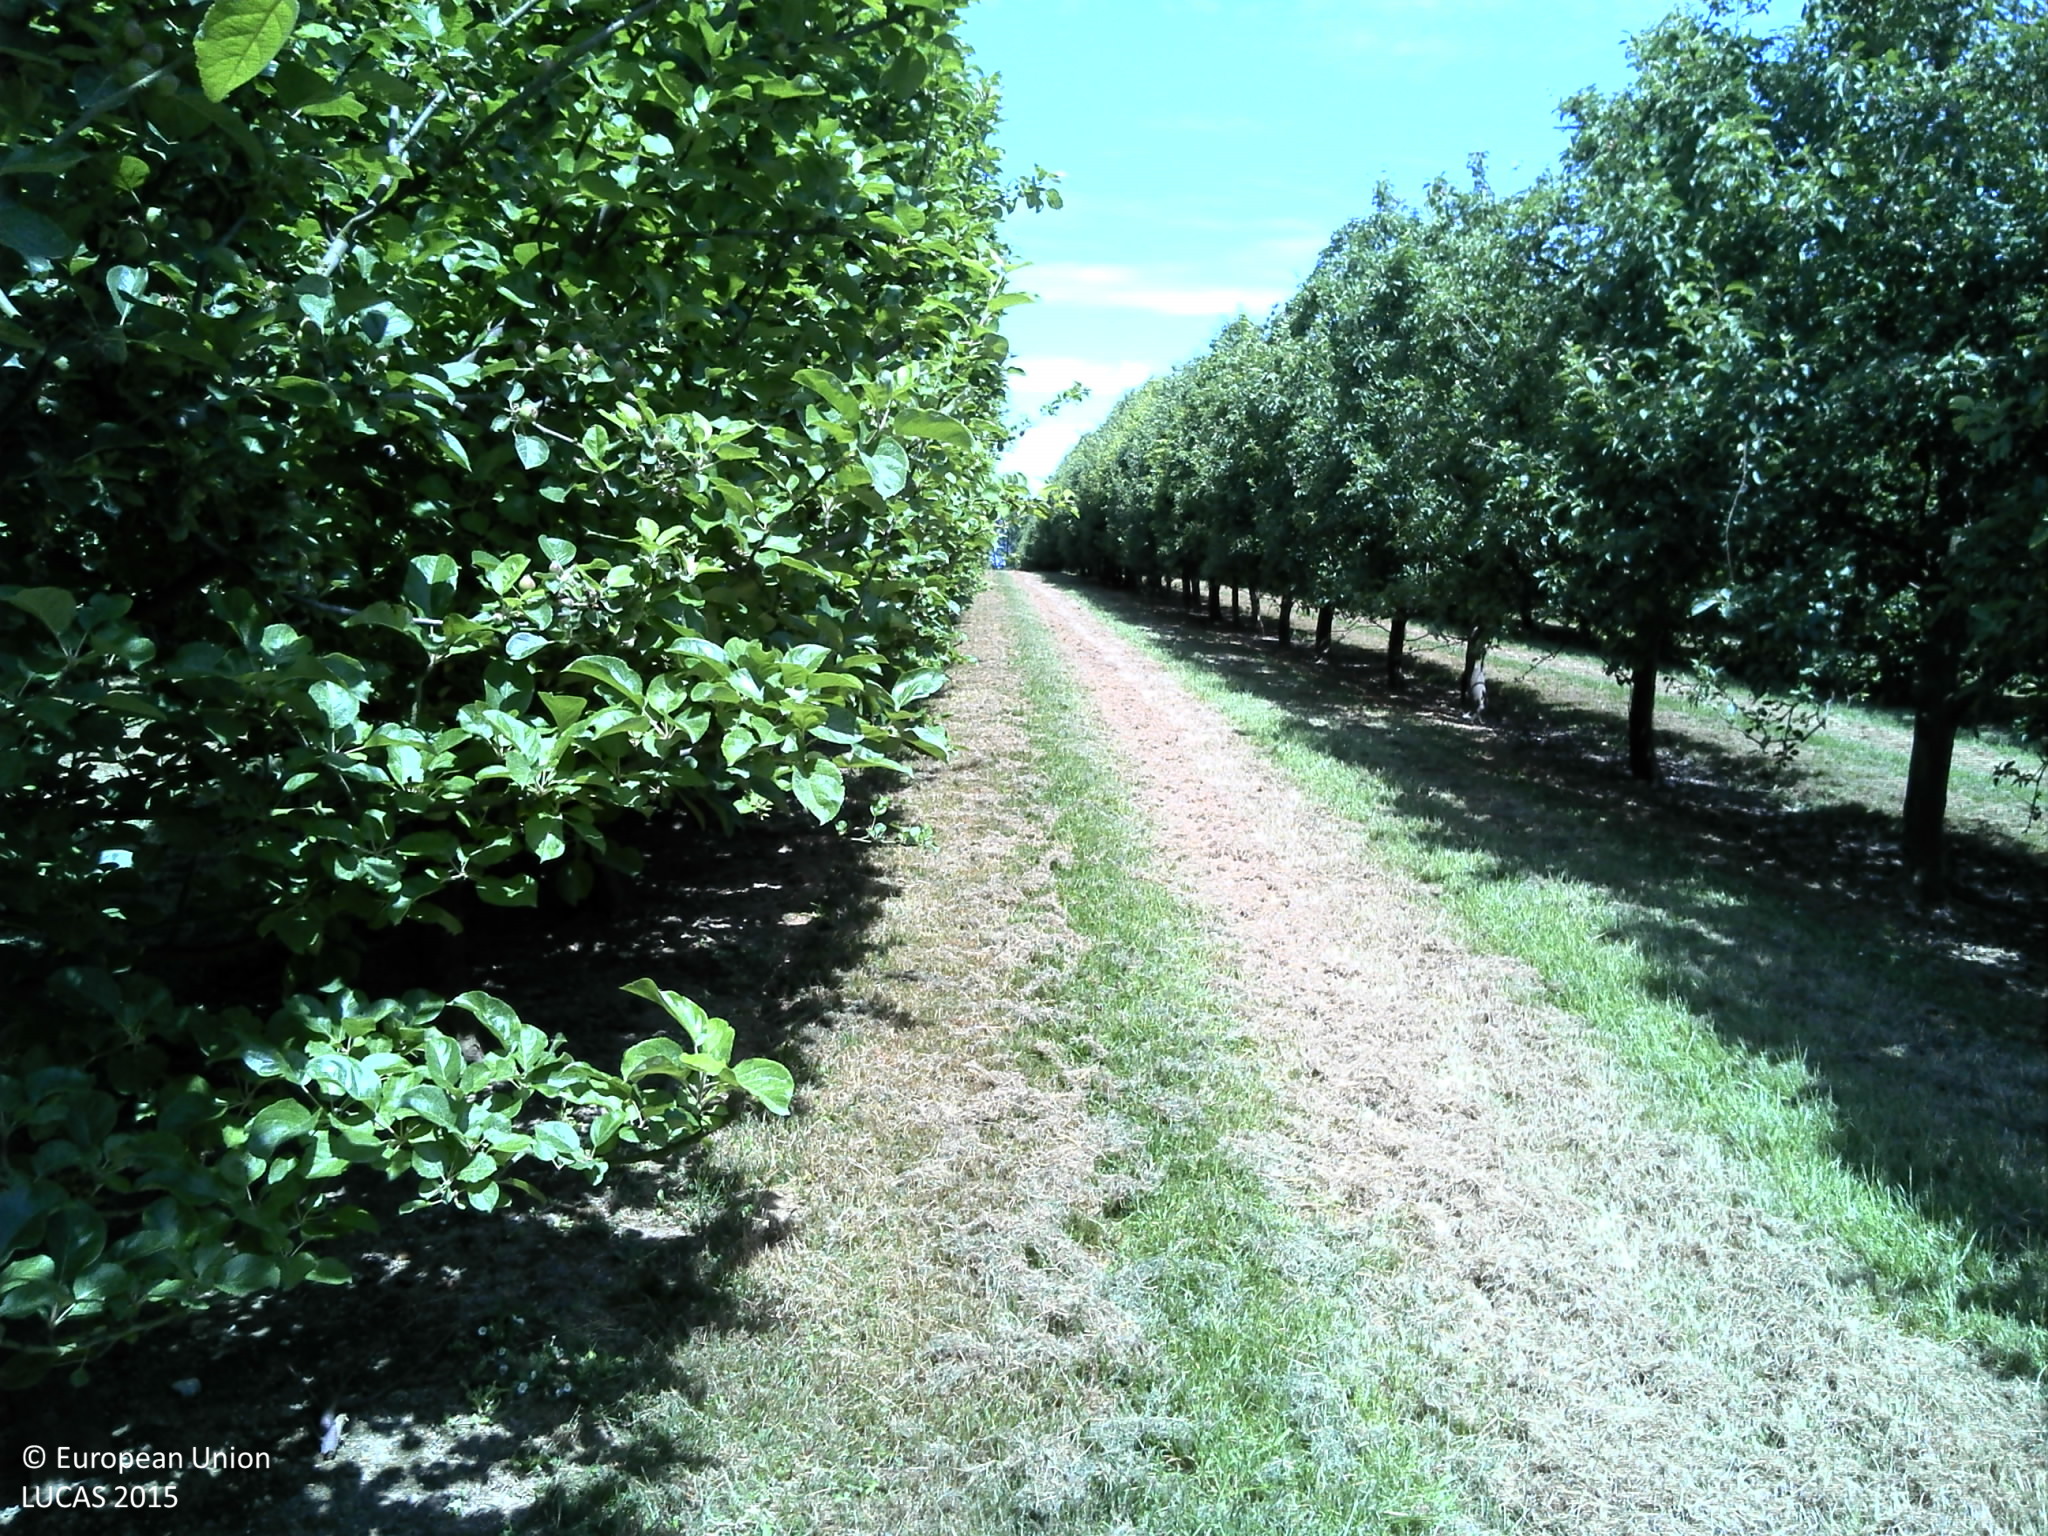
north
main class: Cropland
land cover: Apple fruit
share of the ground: 50 - 75 %
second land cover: Grassland without tree/shrub cover
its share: 50 - 75 %
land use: Agriculture (excluding fallow land and kitchen gardens)
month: June
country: FR
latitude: 49.7816
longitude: 1.1037
